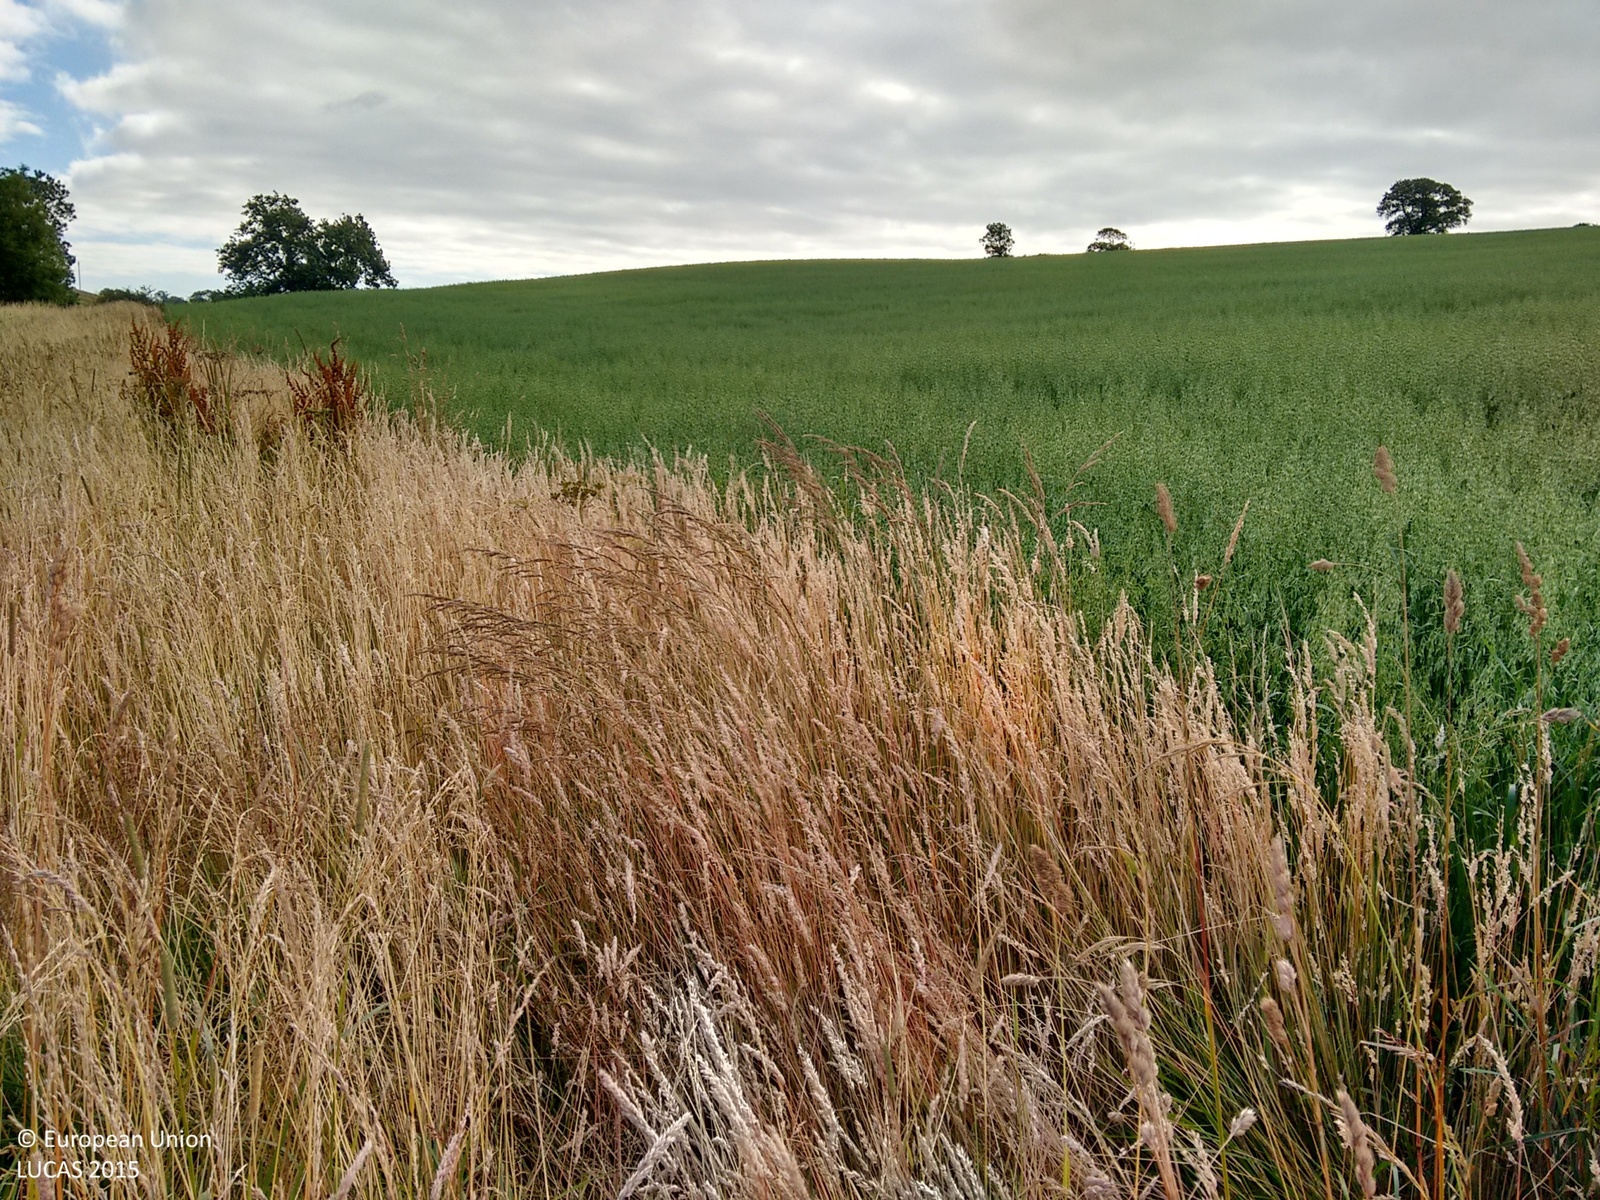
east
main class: Grassland
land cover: Grassland with sparse tree/shrub cover
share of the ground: > 75 %
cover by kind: herbaceous plants 95 %, broadleaved forest trees 5 %
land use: Agriculture (excluding fallow land and kitchen gardens)
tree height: < 5 m
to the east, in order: Grassland with sparse tree/shrub cover; Oats; Spontaneously vegetated surfaces; Grass margins; Managed hedges; Grassland without tree/shrub cover
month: July
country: GB
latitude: 52.6766
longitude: -0.8539
